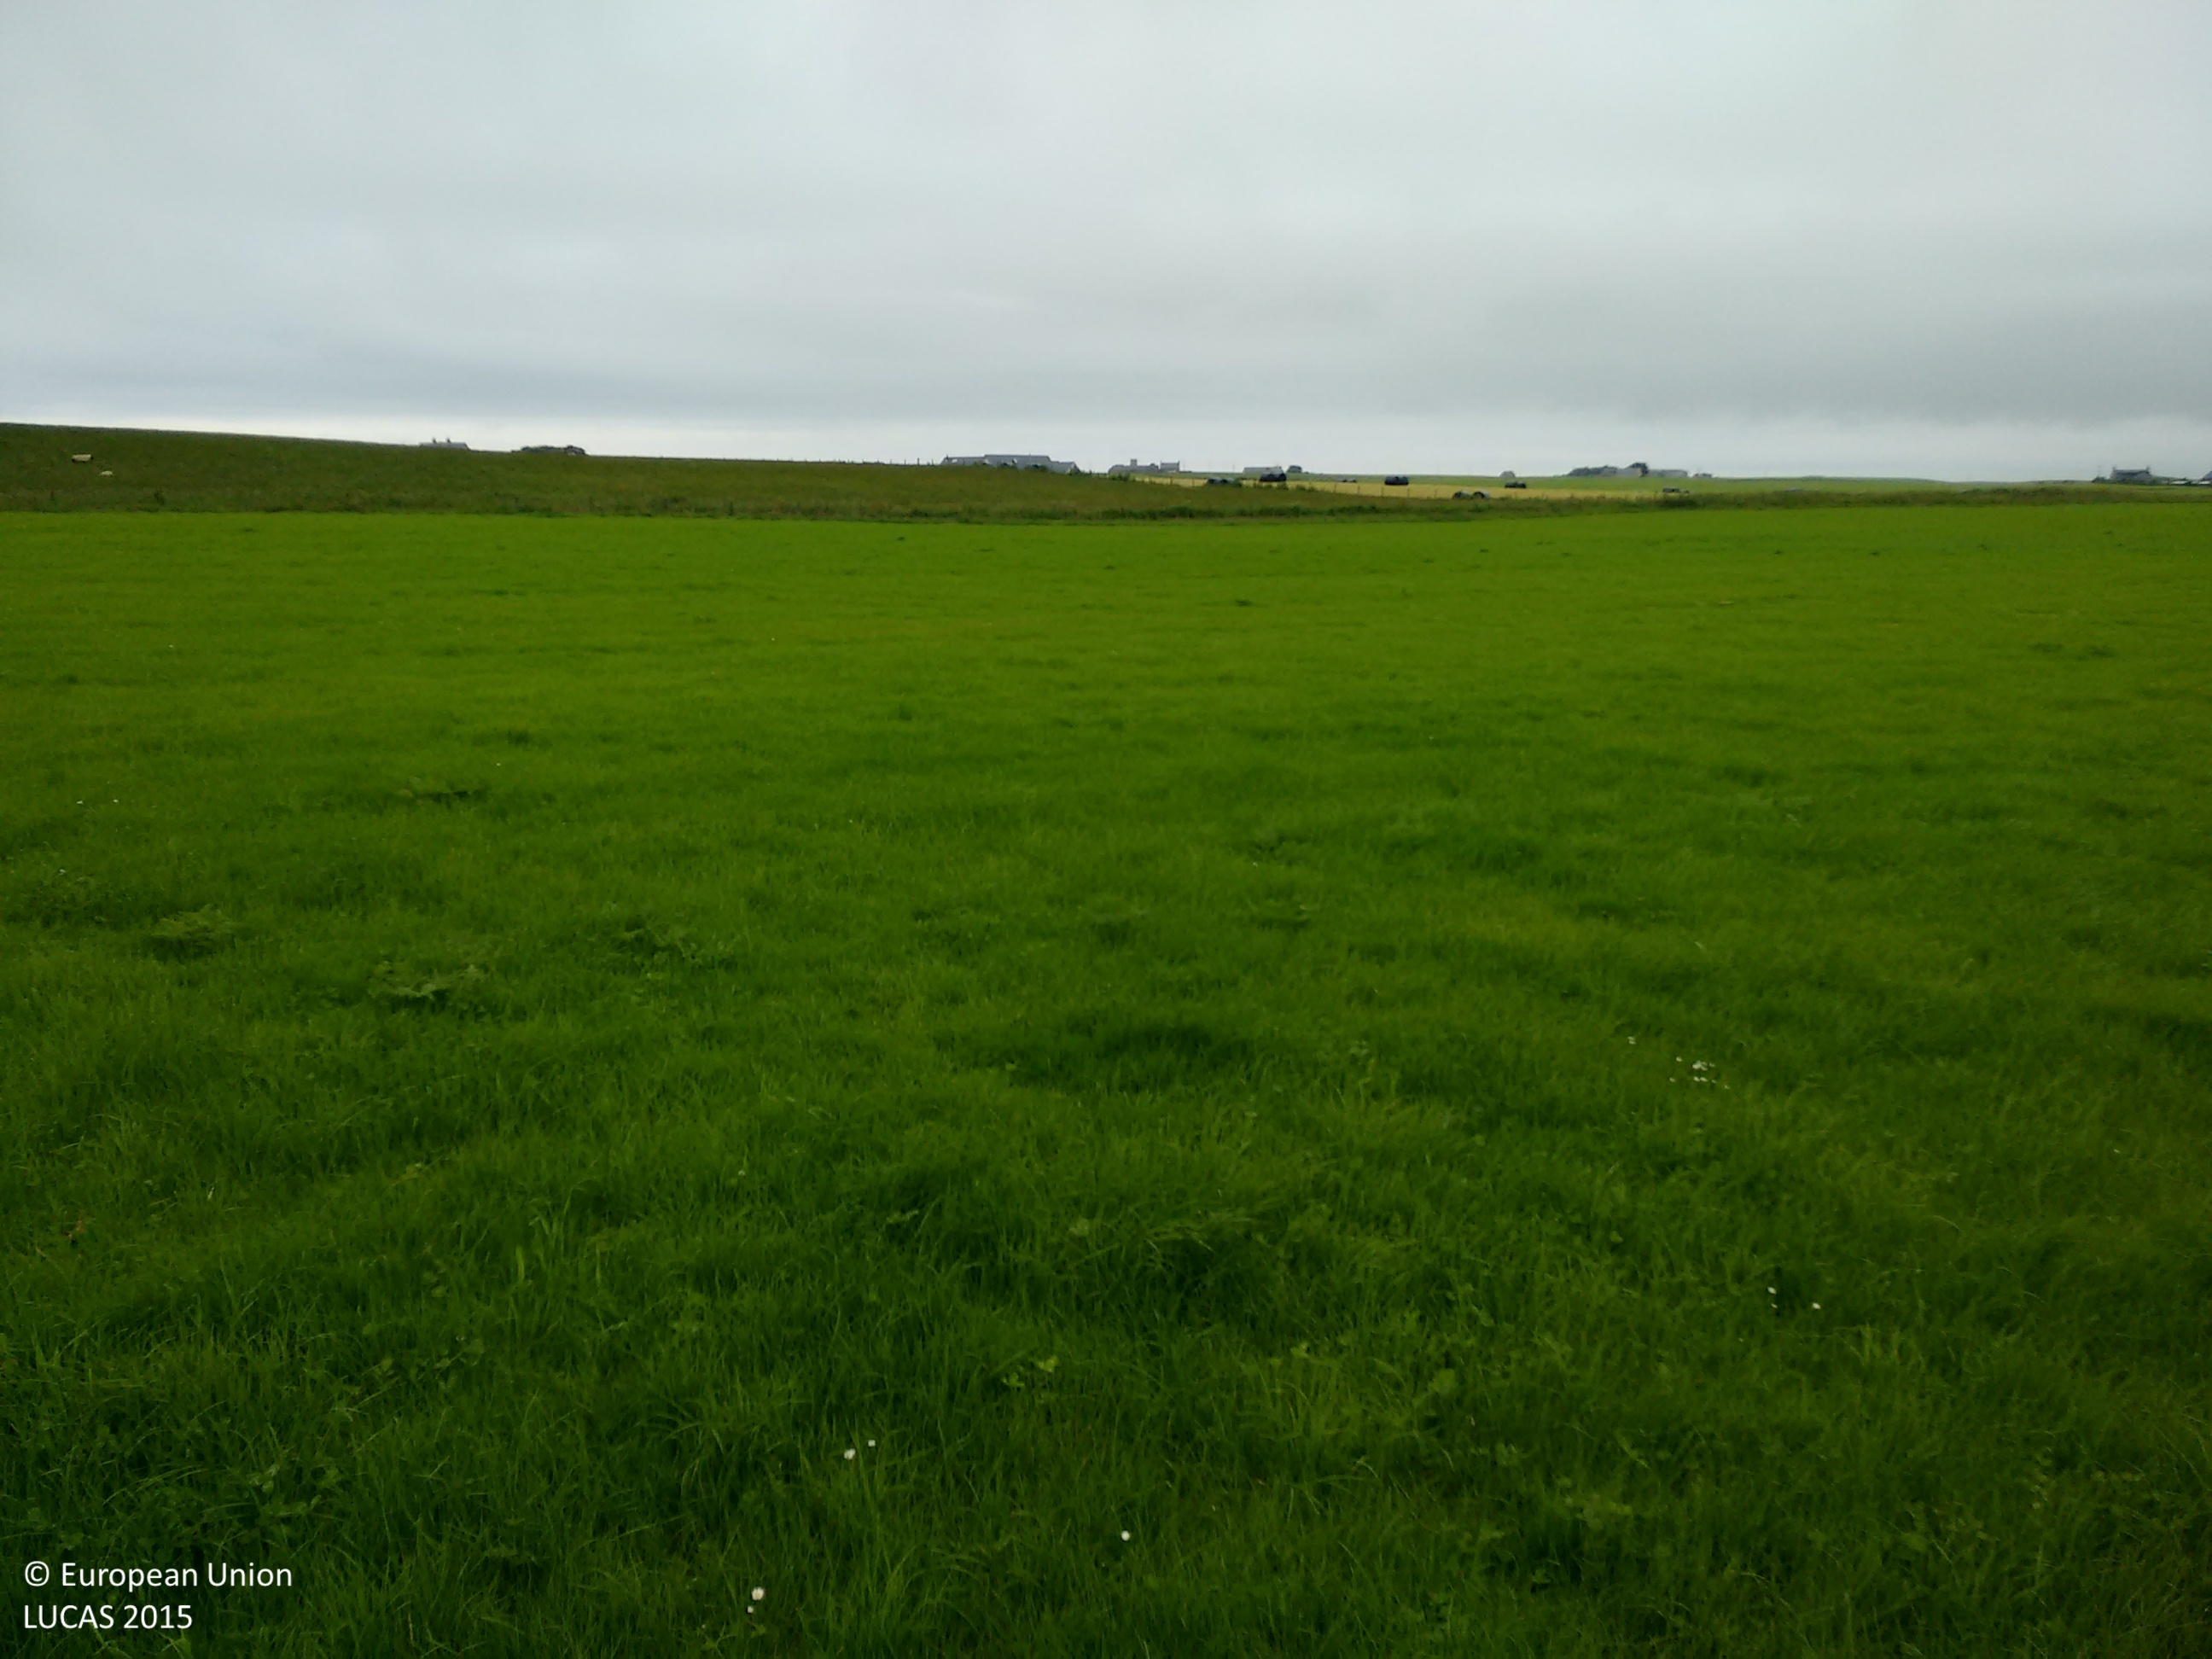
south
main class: Grassland
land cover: Grassland without tree/shrub cover
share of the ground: > 75 %
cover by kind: herbaceous plants 100 %
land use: Agriculture (excluding fallow land and kitchen gardens)
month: July
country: GB
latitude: 57.3758
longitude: -1.9357
